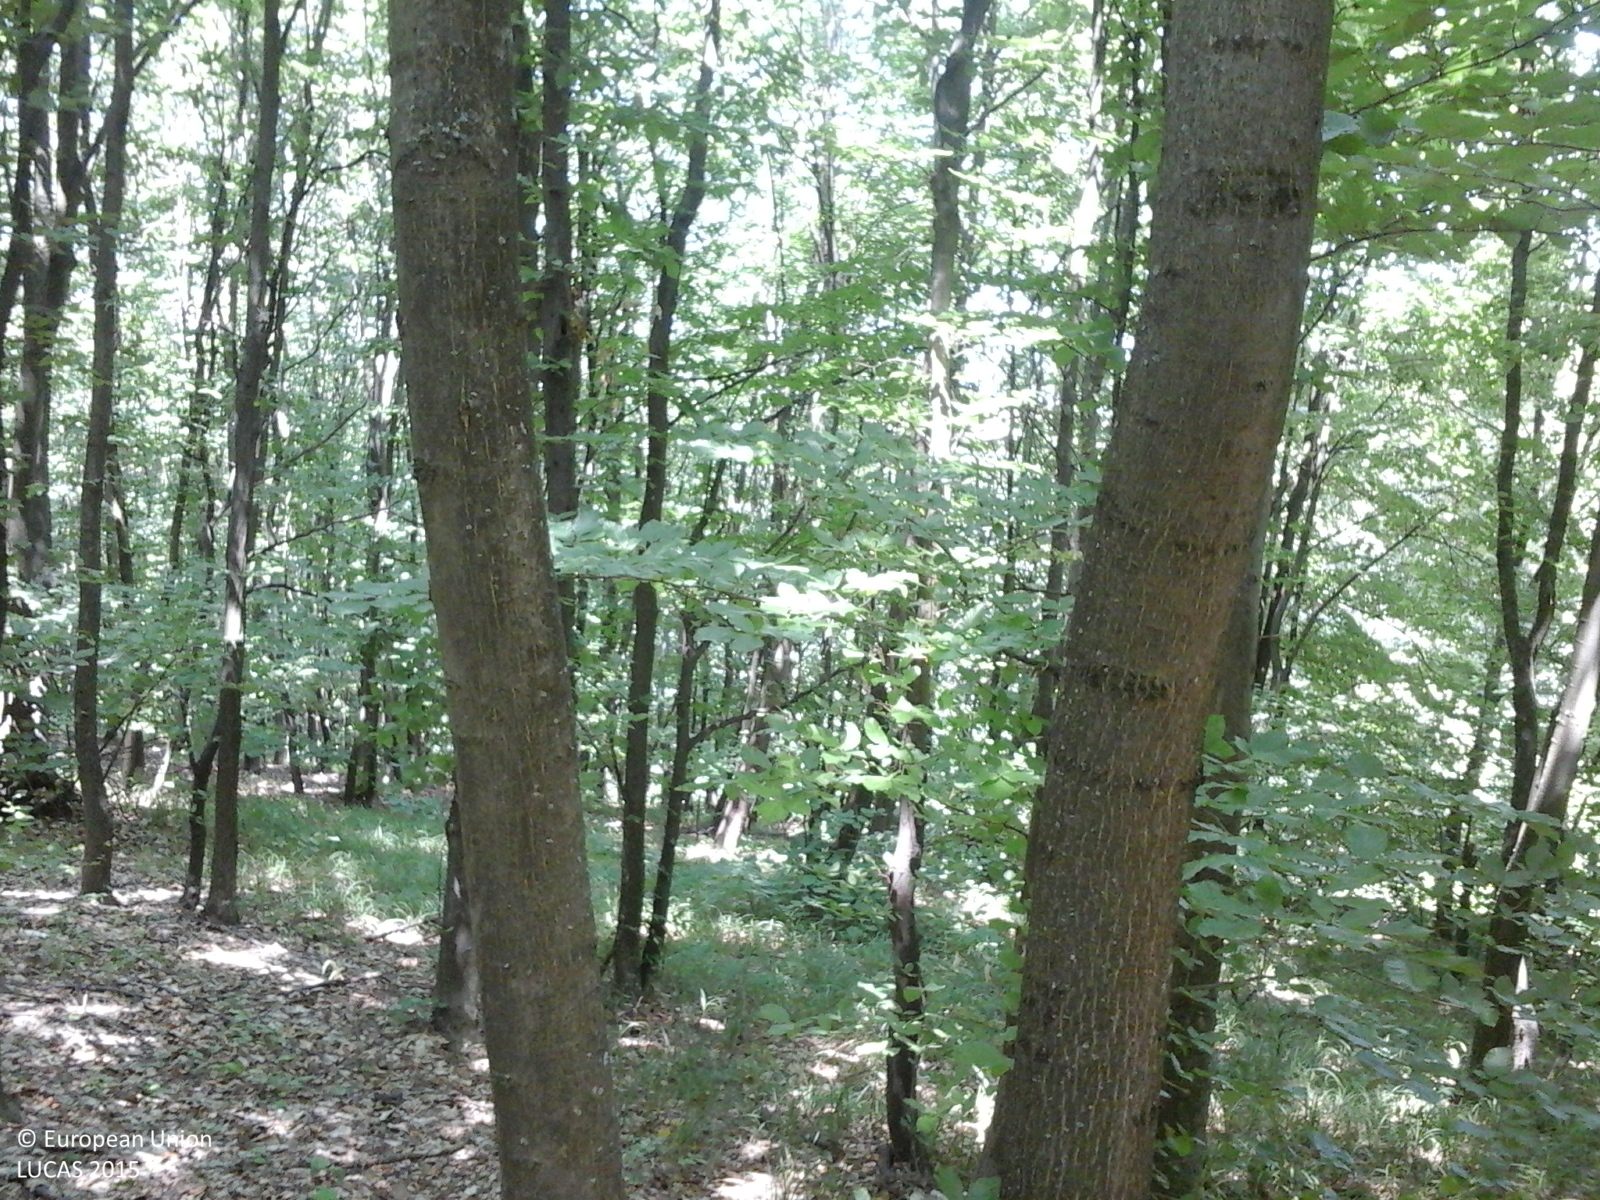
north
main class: Woodland
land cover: Broadleaved woodland
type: beech forest
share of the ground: > 75 %
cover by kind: broadleaved forest trees 100 %
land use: Forestry
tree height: > 5 m
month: June
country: RO
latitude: 46.8315
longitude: 27.9168
